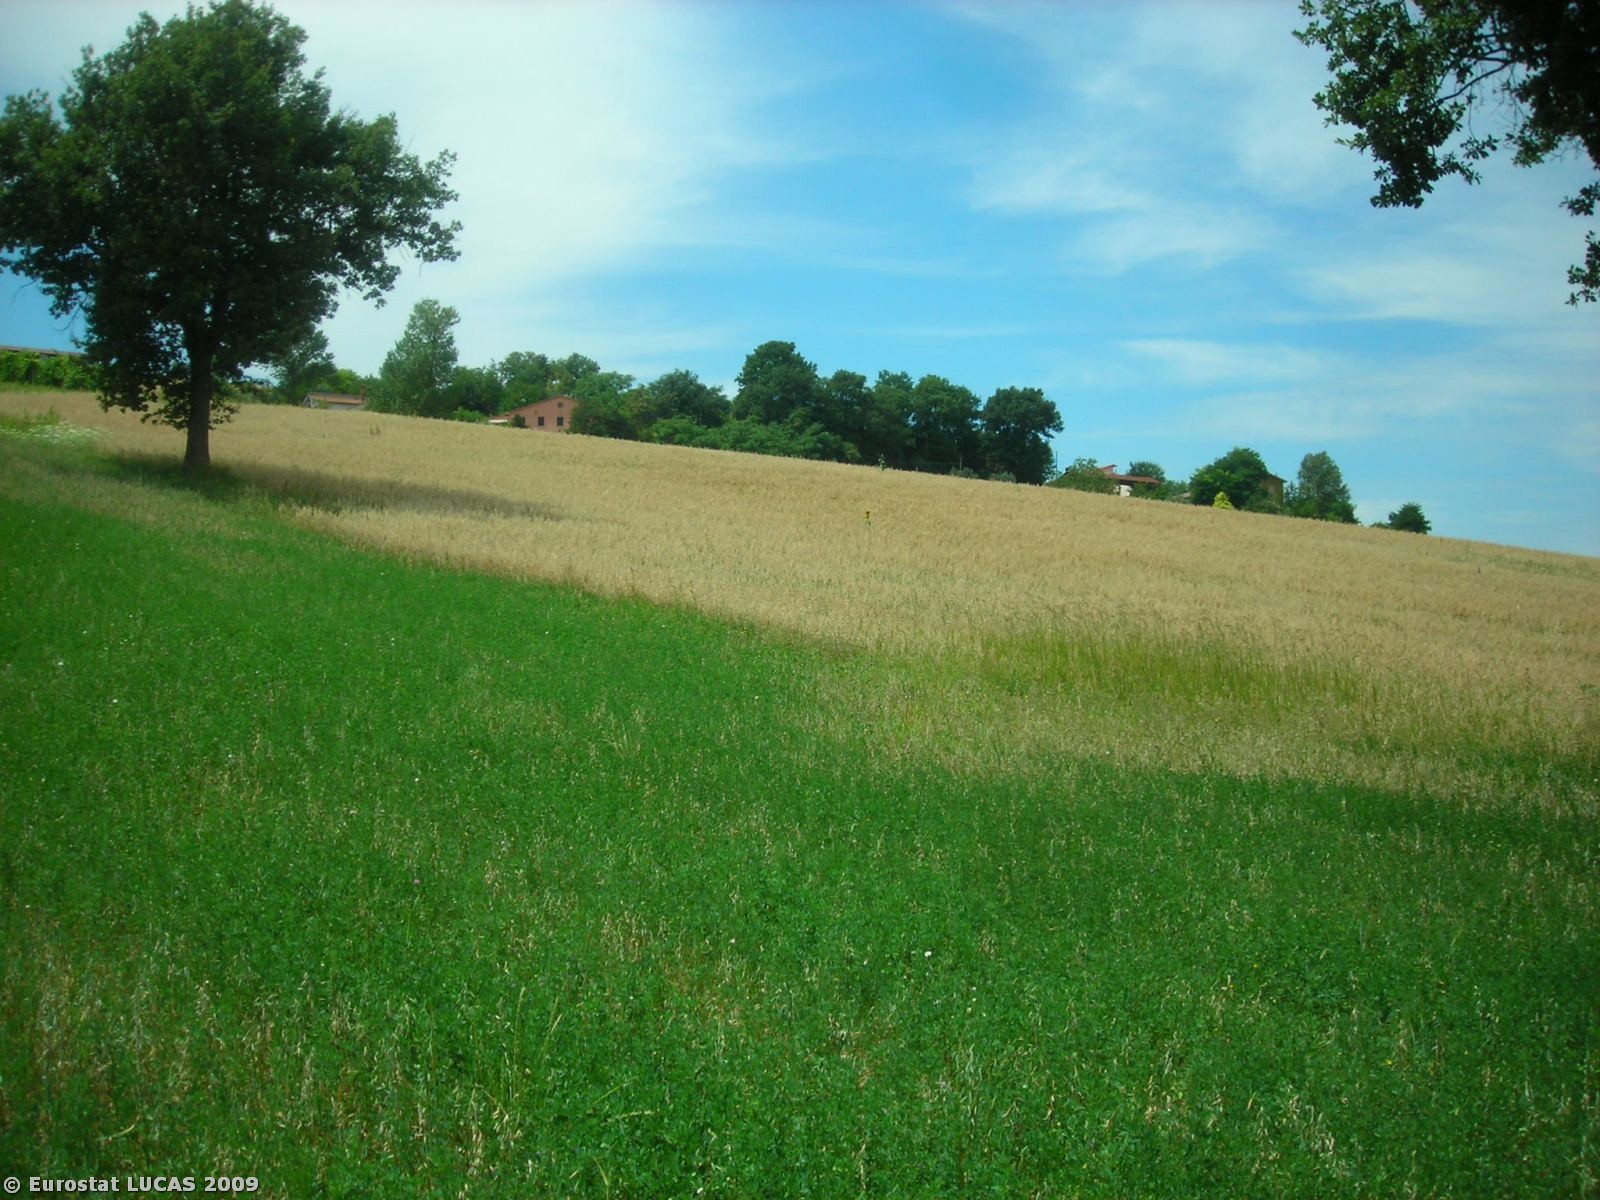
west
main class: Cropland
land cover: Lucerne
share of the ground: > 75 %
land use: Agriculture (excluding fallow land and kitchen gardens)
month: July
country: IT
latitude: 43.2350
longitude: 13.2299
